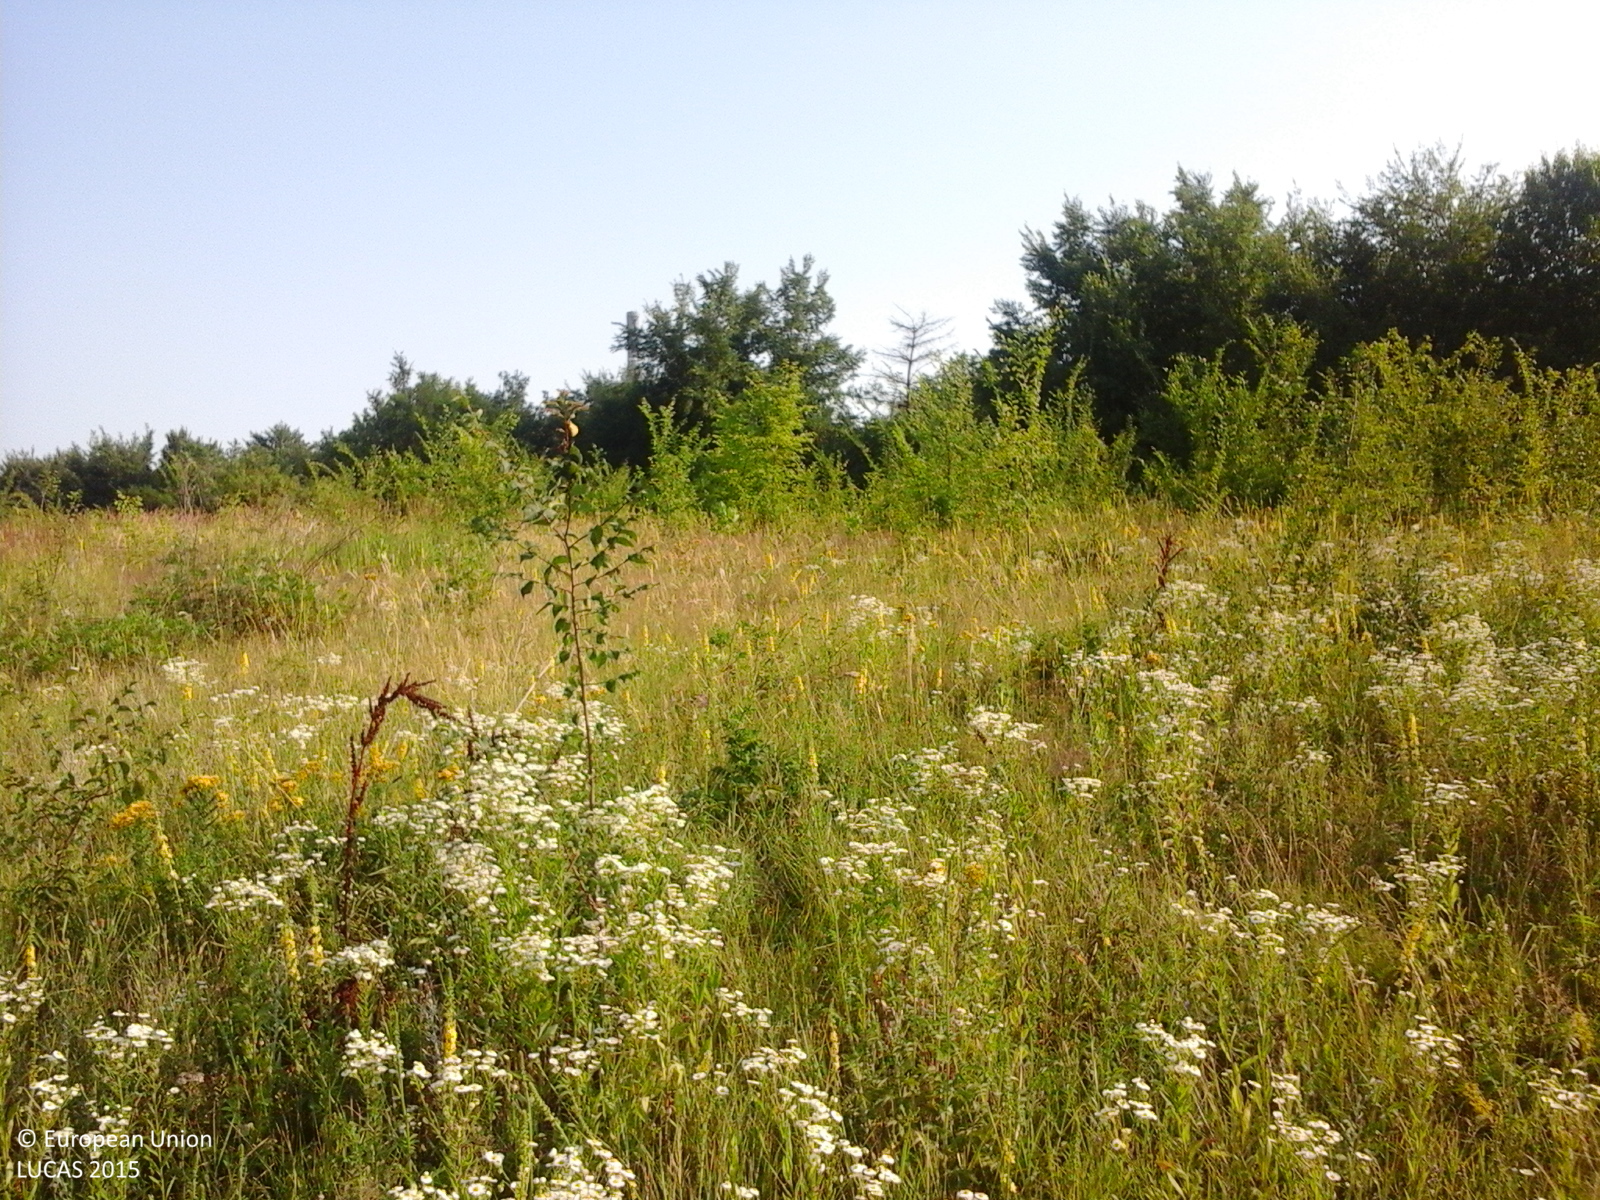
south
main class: Grassland
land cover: Grassland without tree/shrub cover
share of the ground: > 75 %
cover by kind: herbaceous plants 100 %
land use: Semi-natural and natural areas not in use
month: July
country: RO
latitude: 44.8219
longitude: 24.9169
